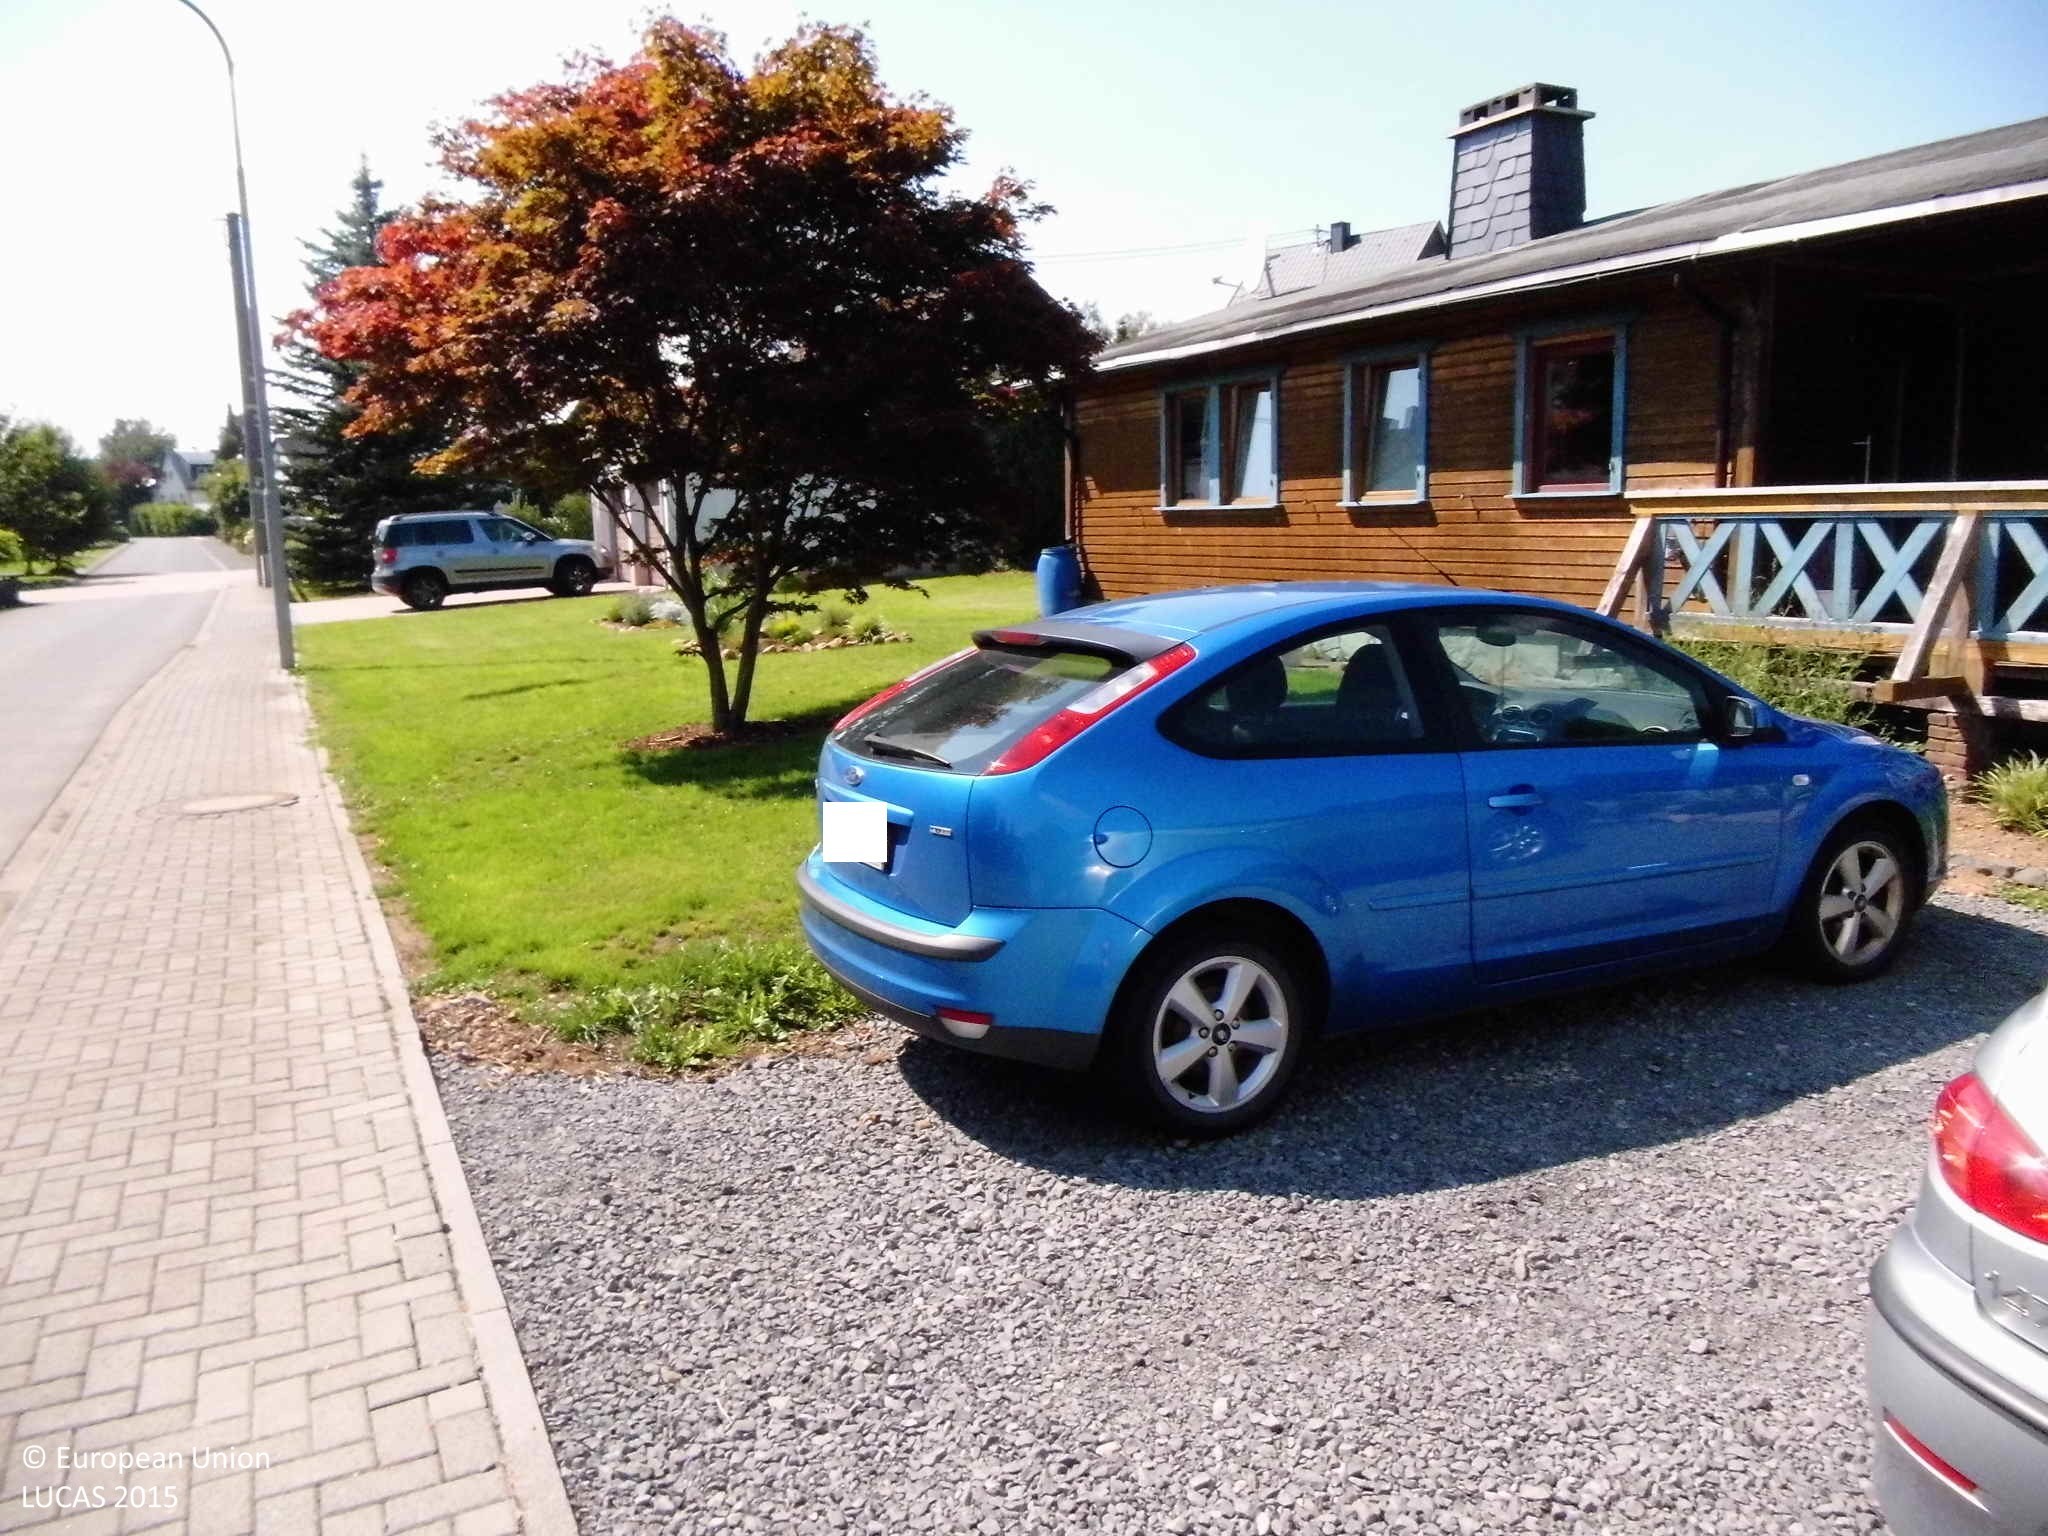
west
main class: Cropland
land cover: Floriculture and ornamental plants
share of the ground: > 75 %
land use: Residential
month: August
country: DE
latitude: 50.6364
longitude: 8.1199
